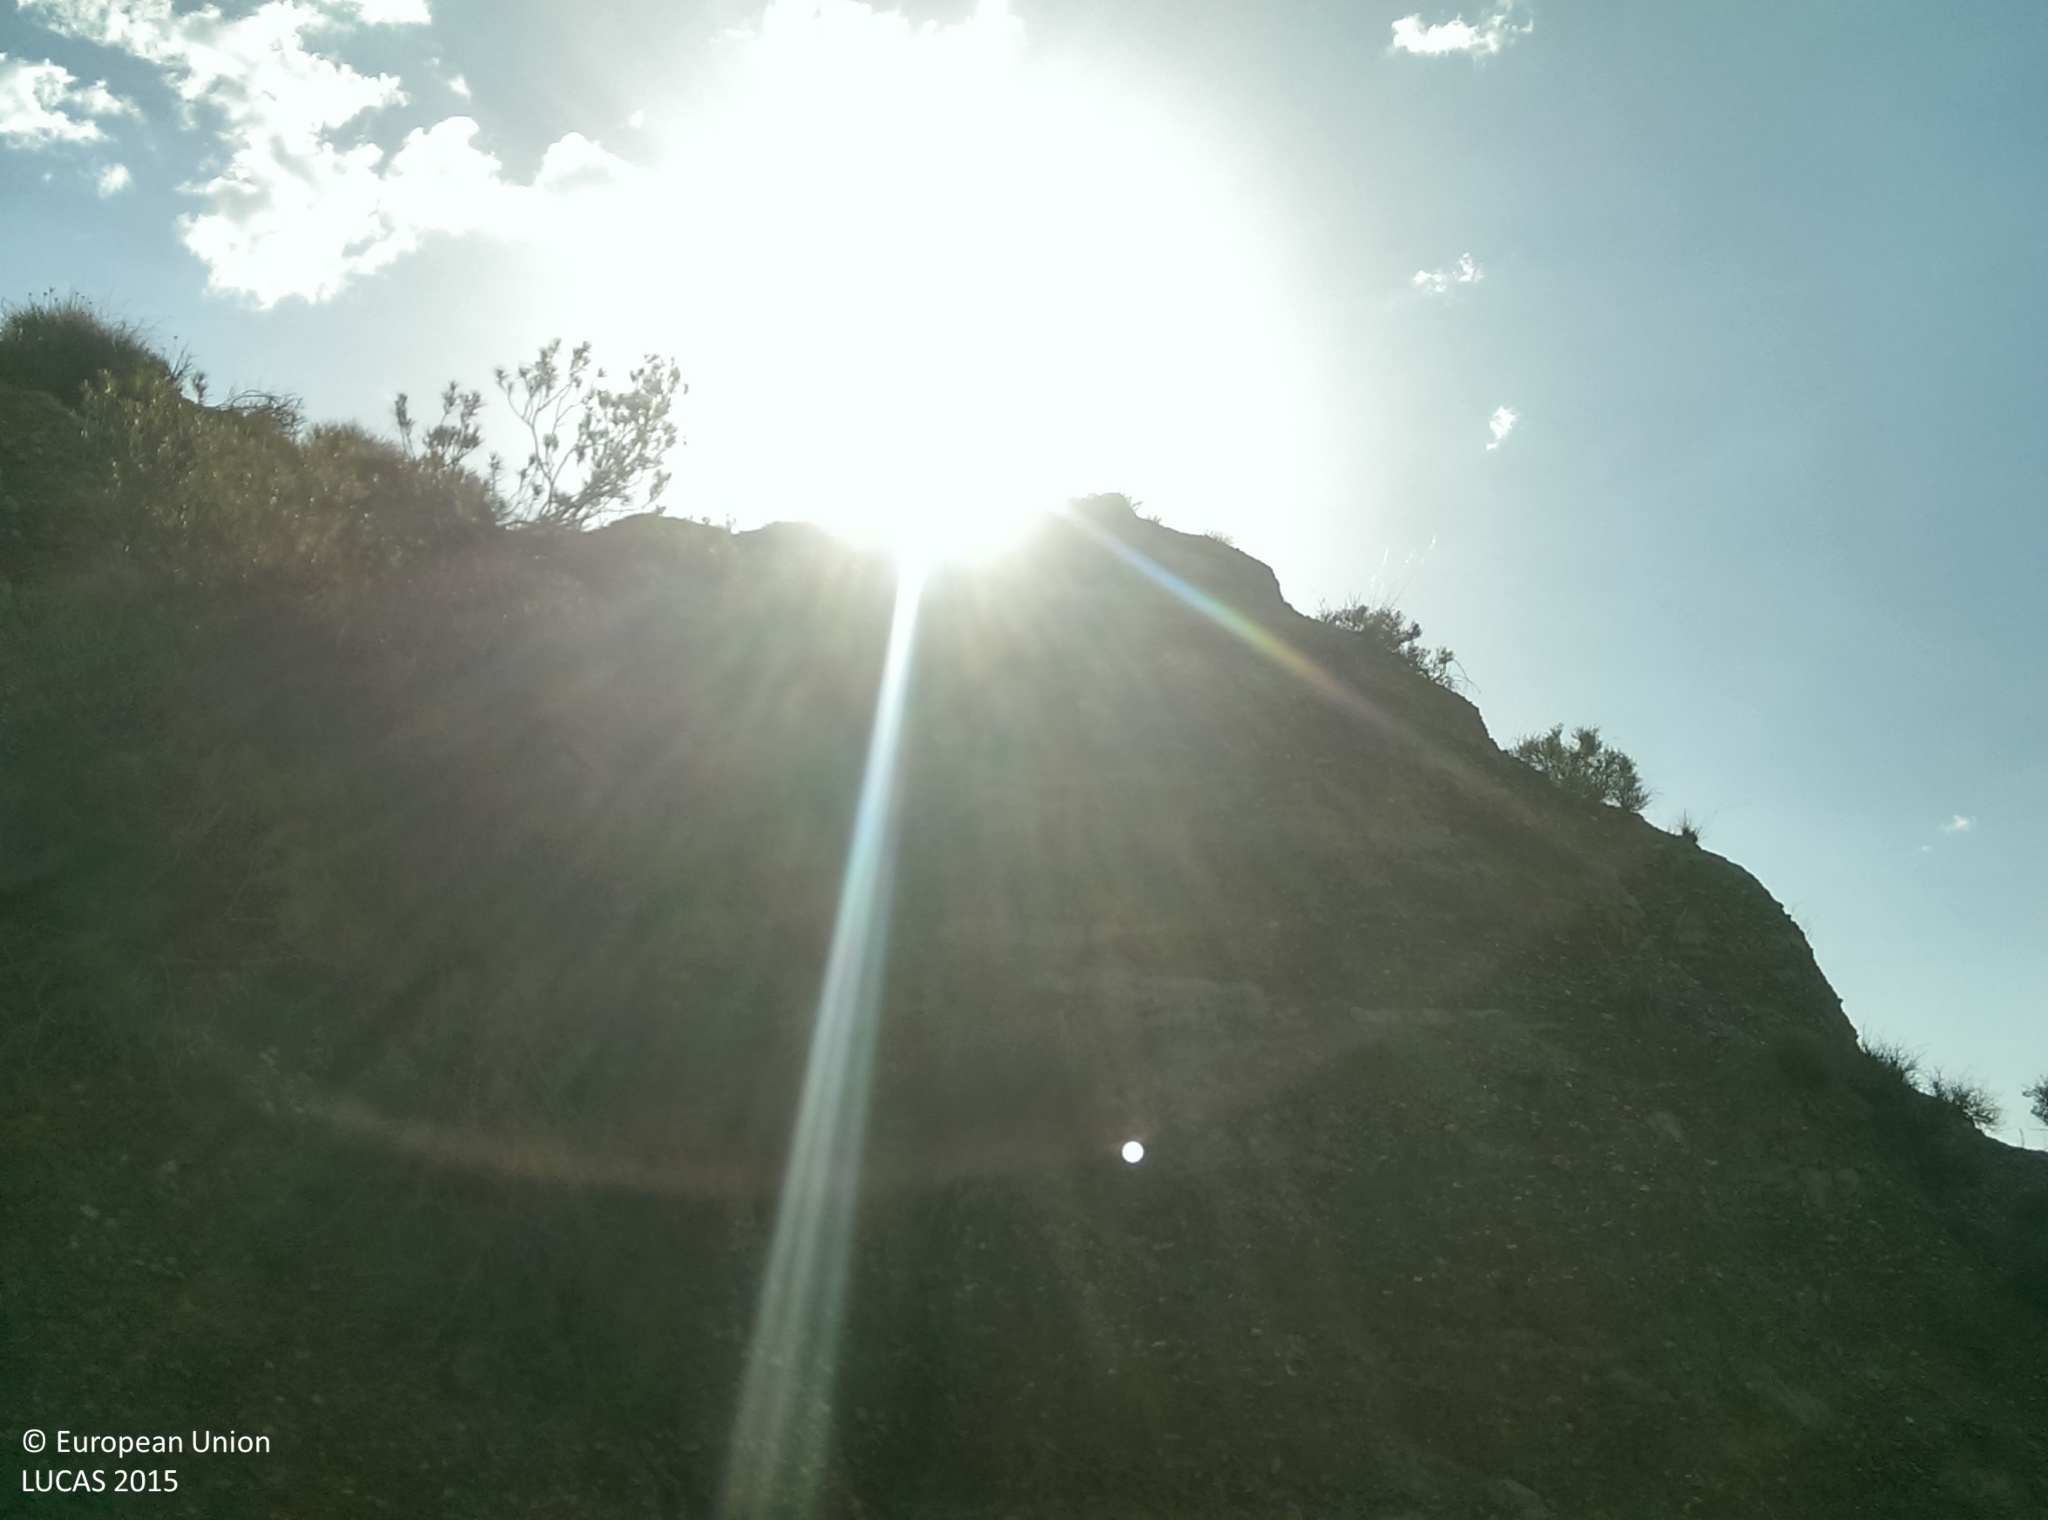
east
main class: Woodland
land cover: Pine dominated coniferous woodland
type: coniferous forest of the mediterranean region
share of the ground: 25 - 50 %
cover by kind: unconsolidated bare surface 40 %, coniferous forest trees 25 %, herbaceous plants 20 %, shrubs 15 %
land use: Forestry
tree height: > 5 m
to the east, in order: Pine dominated coniferous woodland
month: July
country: ES
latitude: 37.3213
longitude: -3.1796
